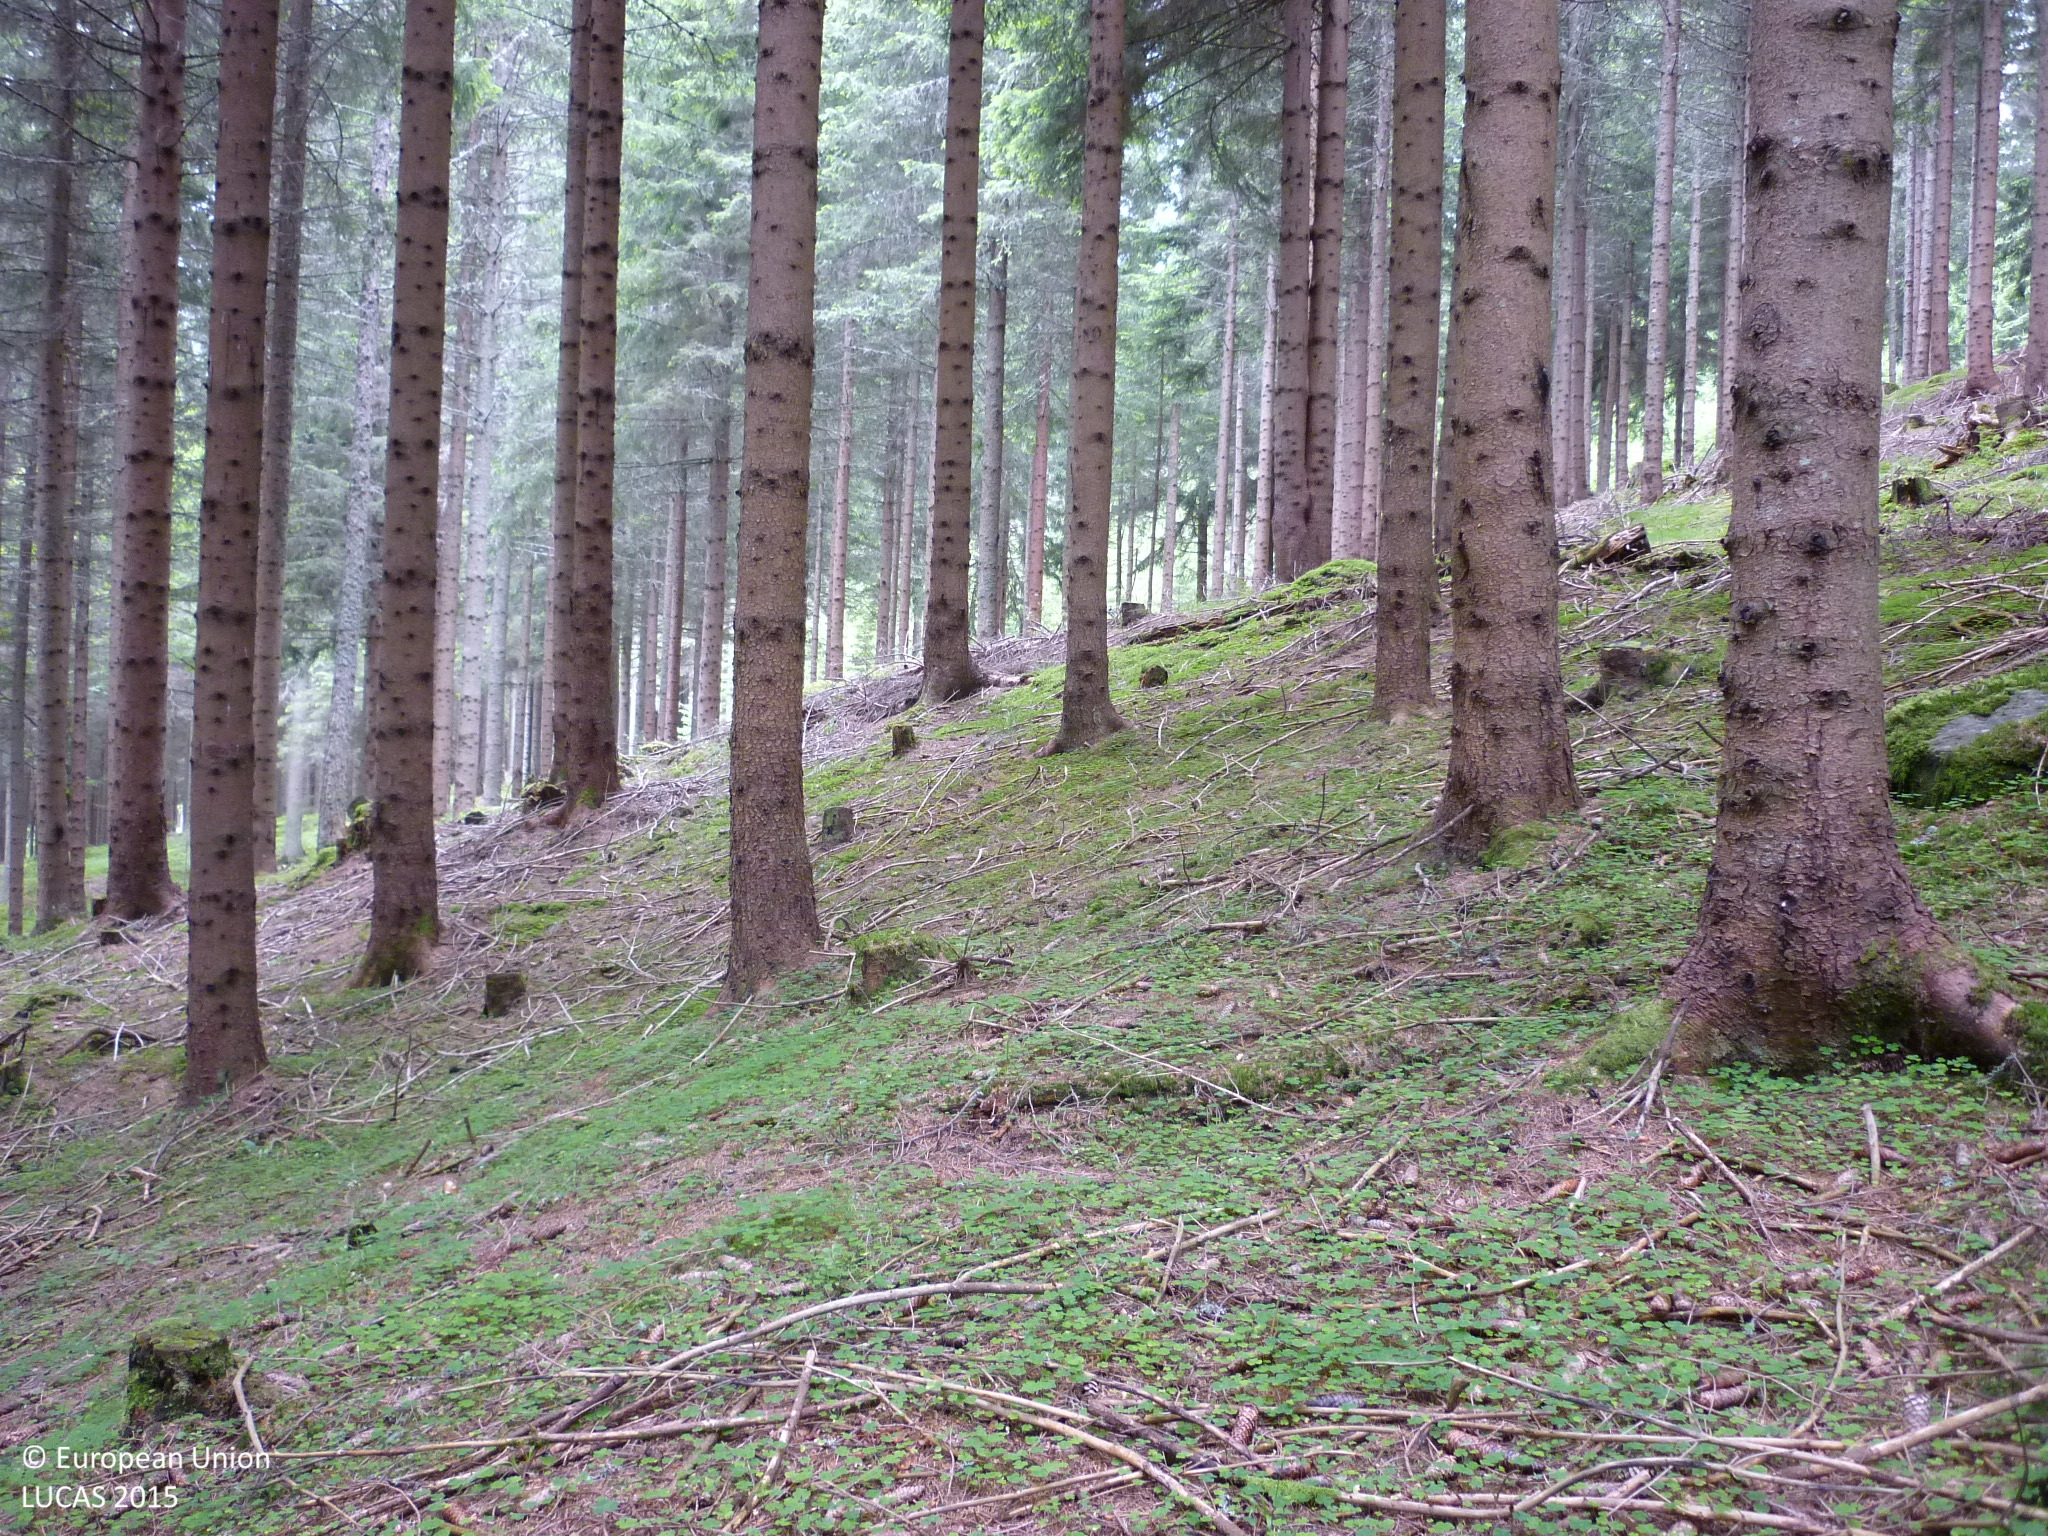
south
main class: Woodland
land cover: Spruce dominated coniferous woodland
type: alpine coniferous forest
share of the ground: > 75 %
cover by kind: coniferous forest trees 100 %
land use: Forestry
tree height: > 5 m
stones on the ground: < 10 %
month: June
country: AT
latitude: 47.2578
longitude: 14.2669
